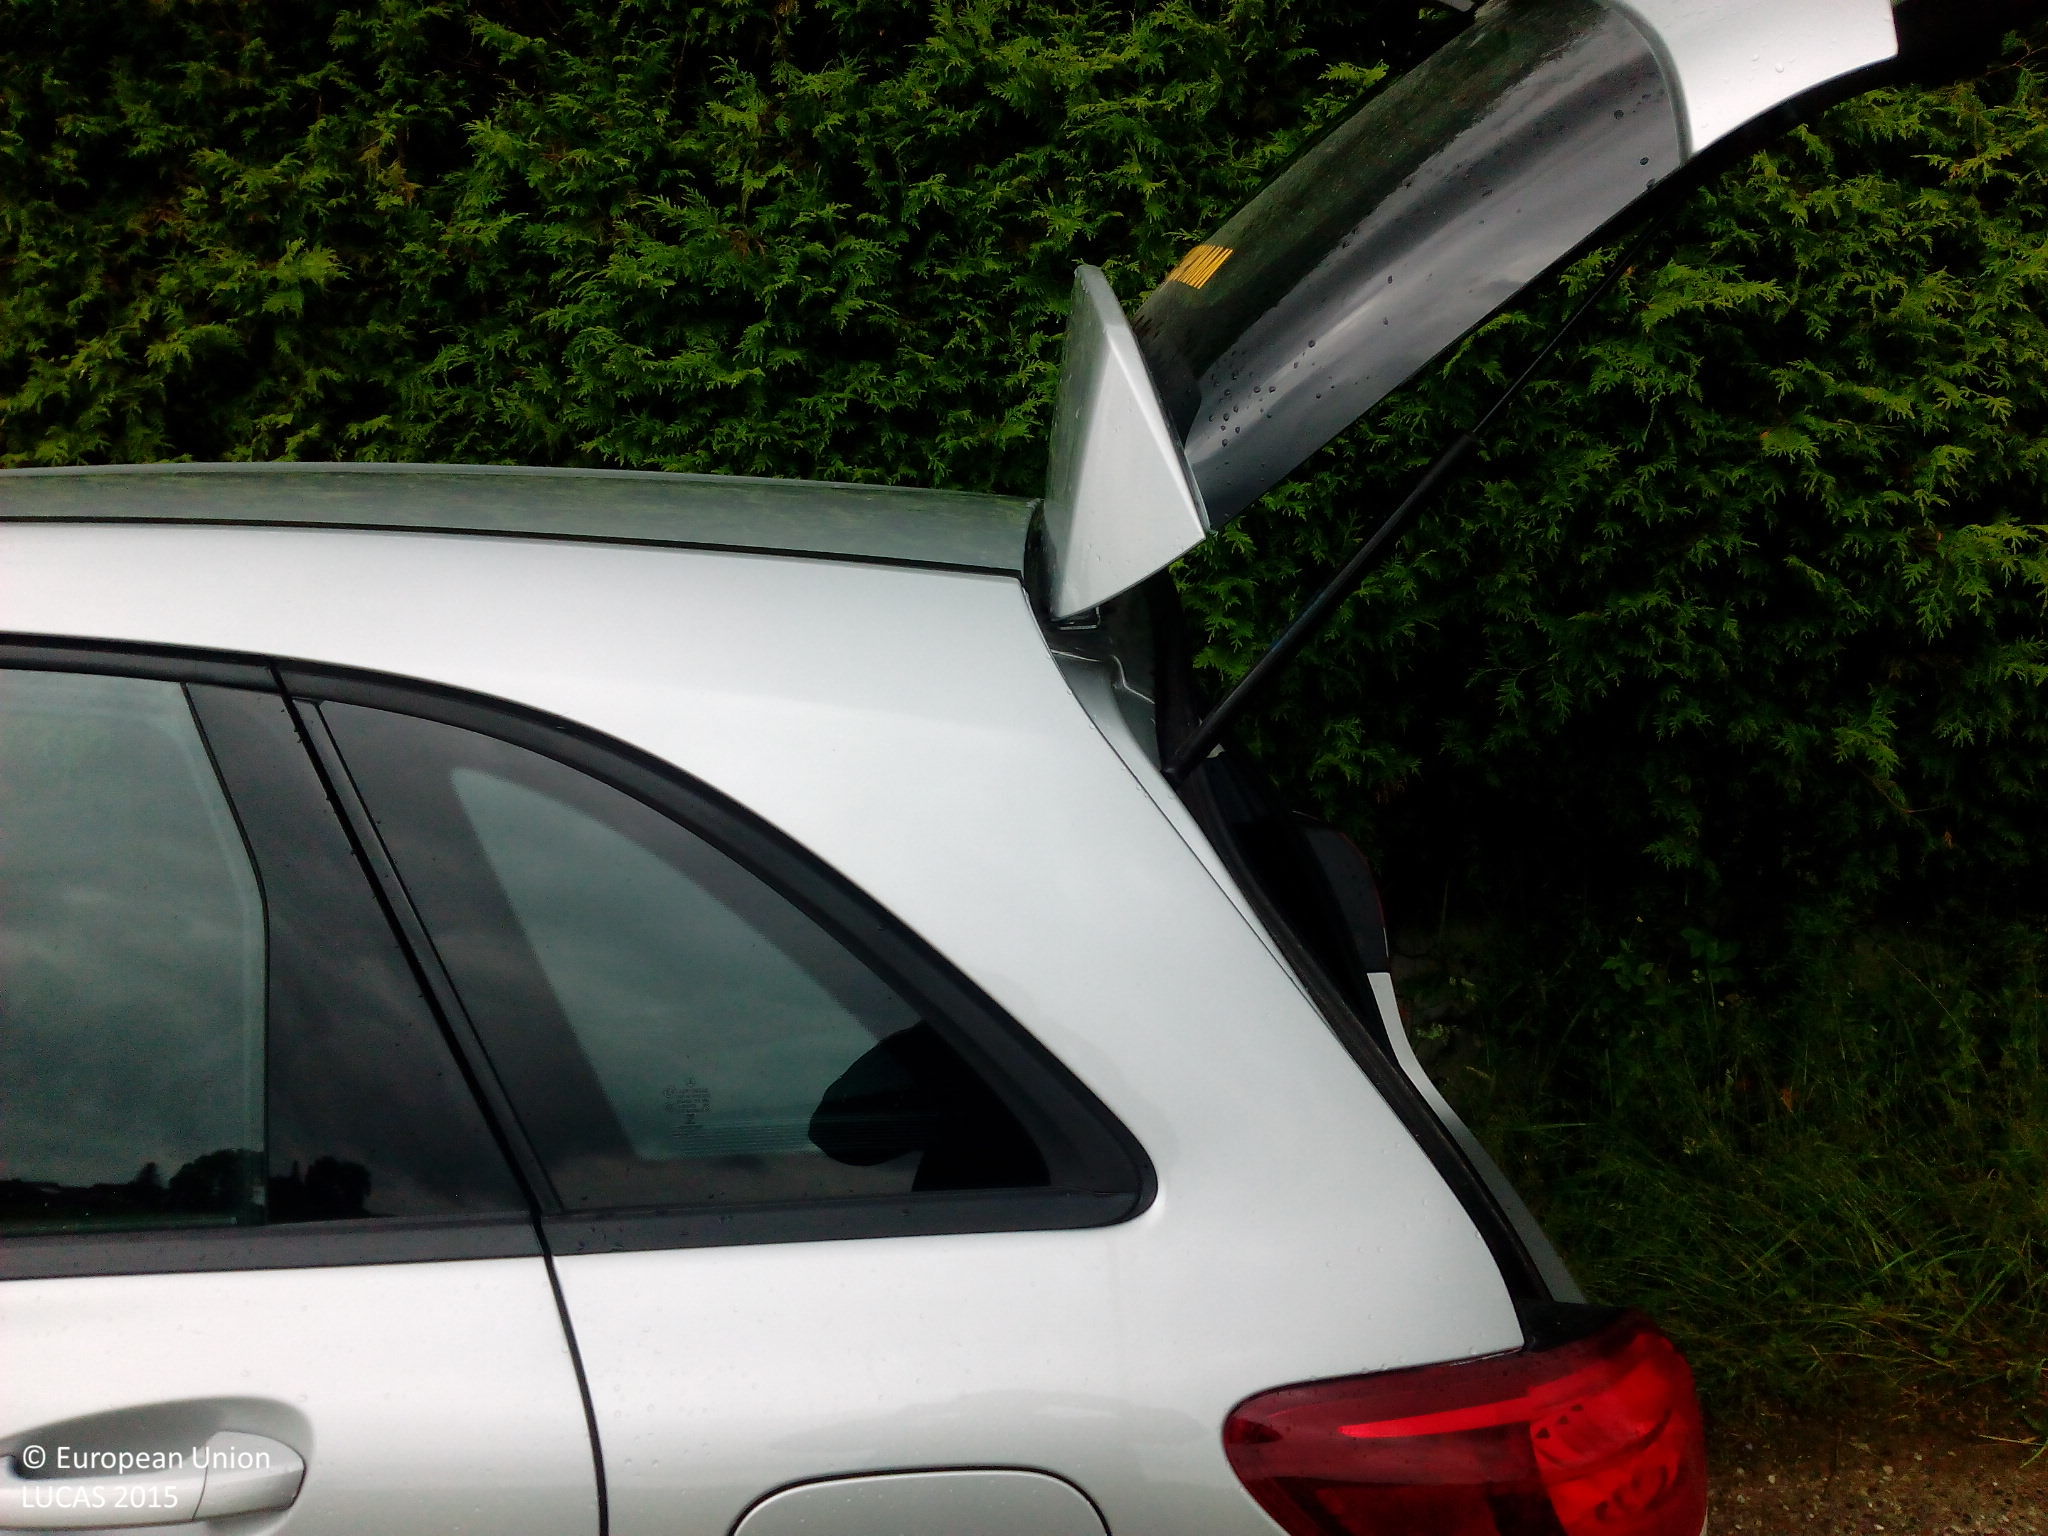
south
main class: Grassland
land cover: Grassland without tree/shrub cover
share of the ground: > 75 %
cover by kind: herbaceous plants 100 %
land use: Agriculture (excluding fallow land and kitchen gardens)
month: June
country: DE
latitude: 47.7000
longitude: 10.5992
